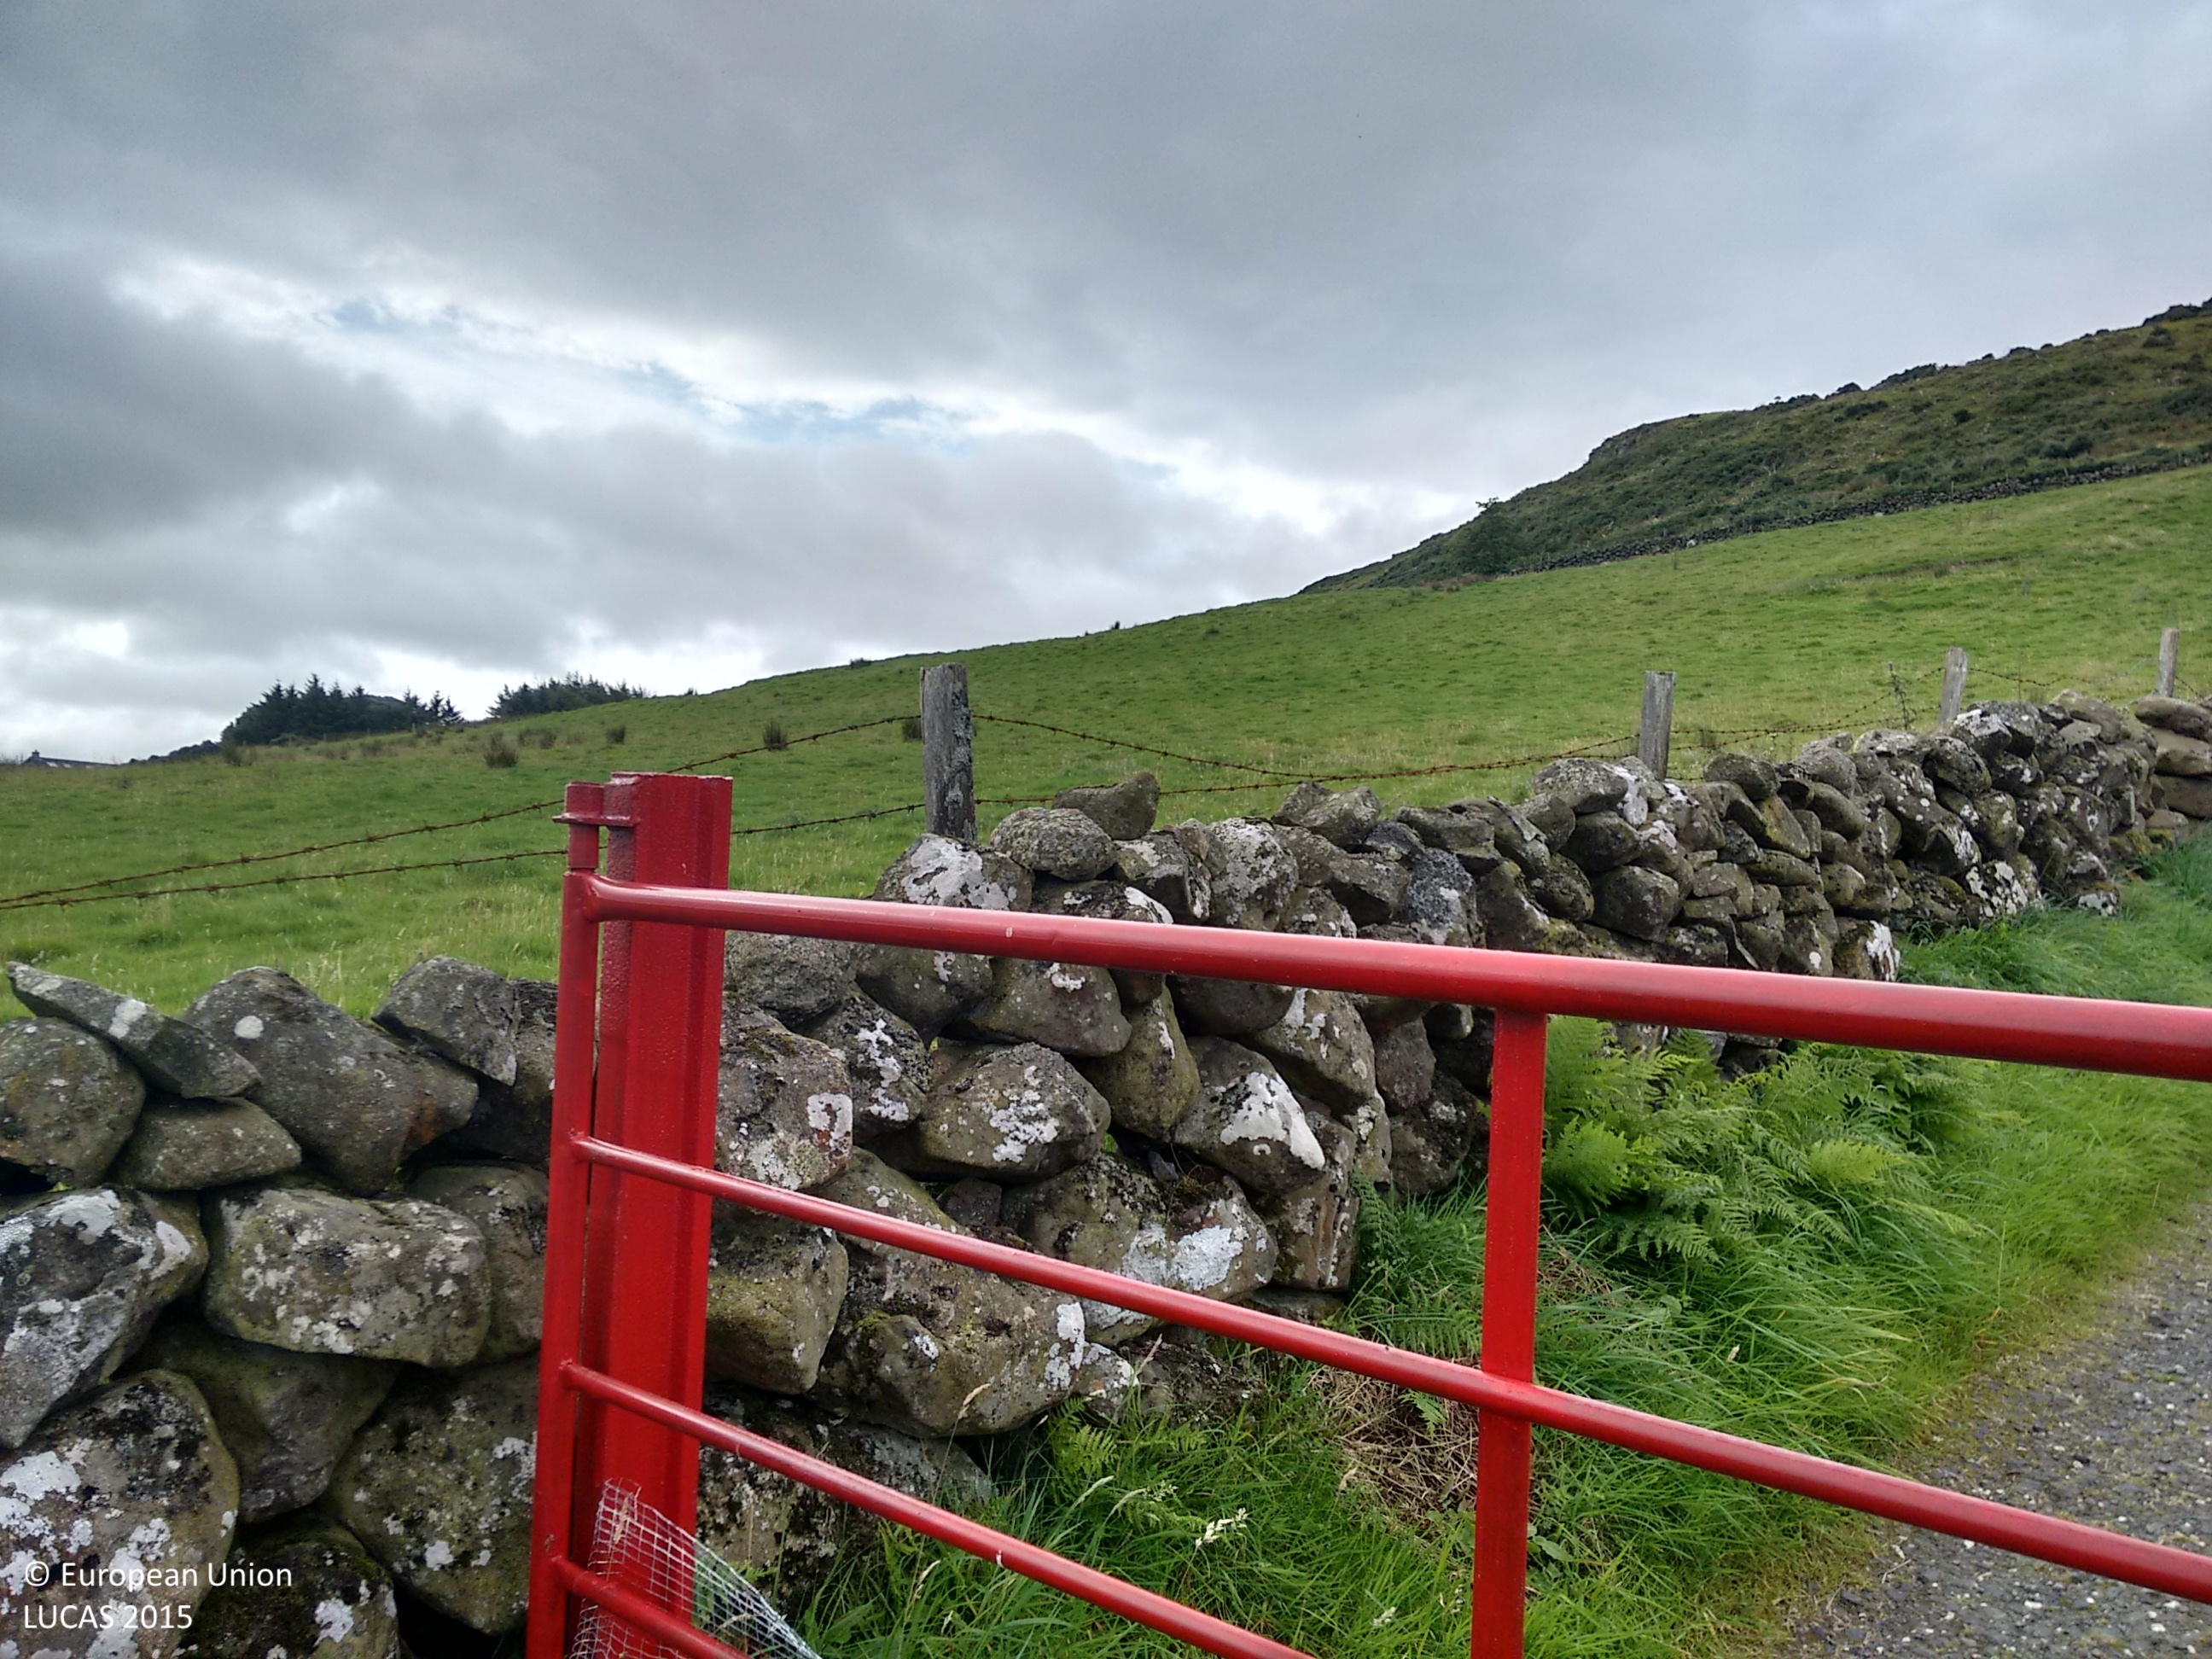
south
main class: Grassland
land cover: Grassland without tree/shrub cover
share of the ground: > 75 %
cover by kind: herbaceous plants 100 %
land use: Agriculture (excluding fallow land and kitchen gardens)
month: September
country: GB
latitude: 54.8929
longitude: -5.9000
